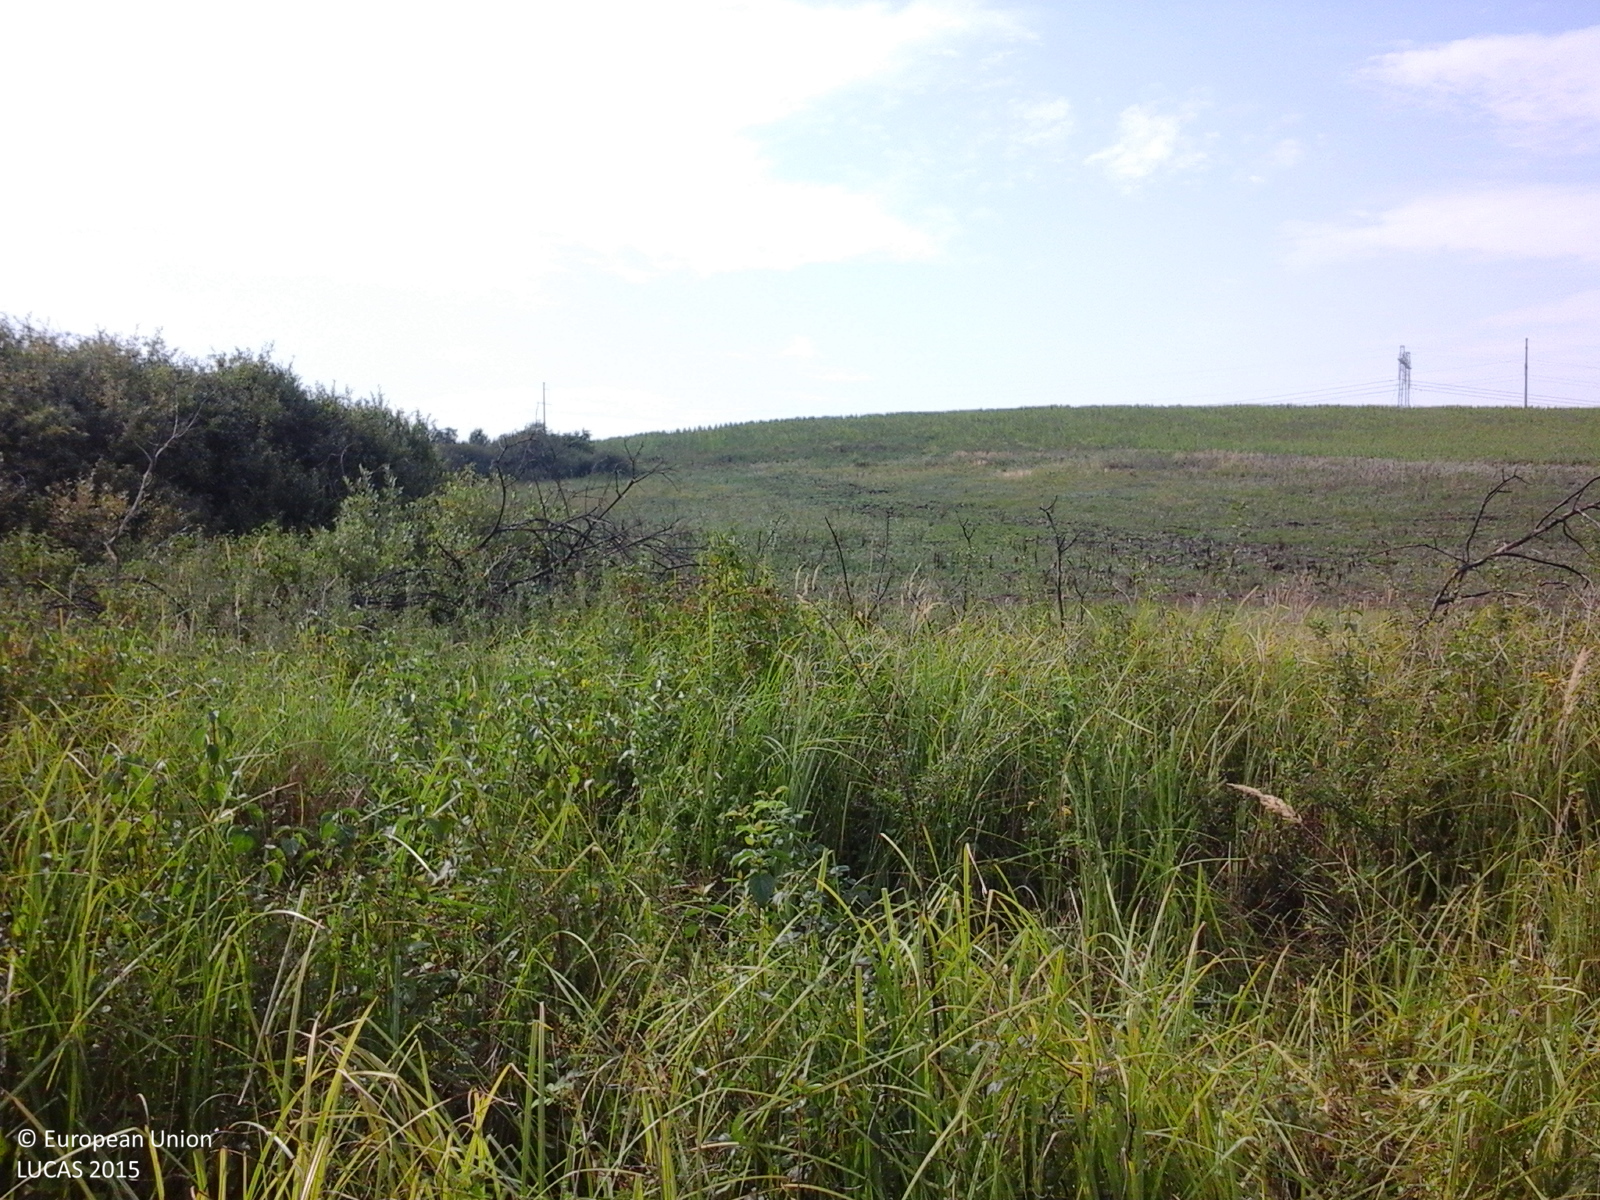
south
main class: Shrubland
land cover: Shrubland with sparse tree cover
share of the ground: > 75 %
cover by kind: herbaceous plants 85 %, shrubs 10 %, broadleaved forest trees 5 %
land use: Semi-natural and natural areas not in use
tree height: < 5 m
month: August
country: RO
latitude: 46.0710
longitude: 21.5297
